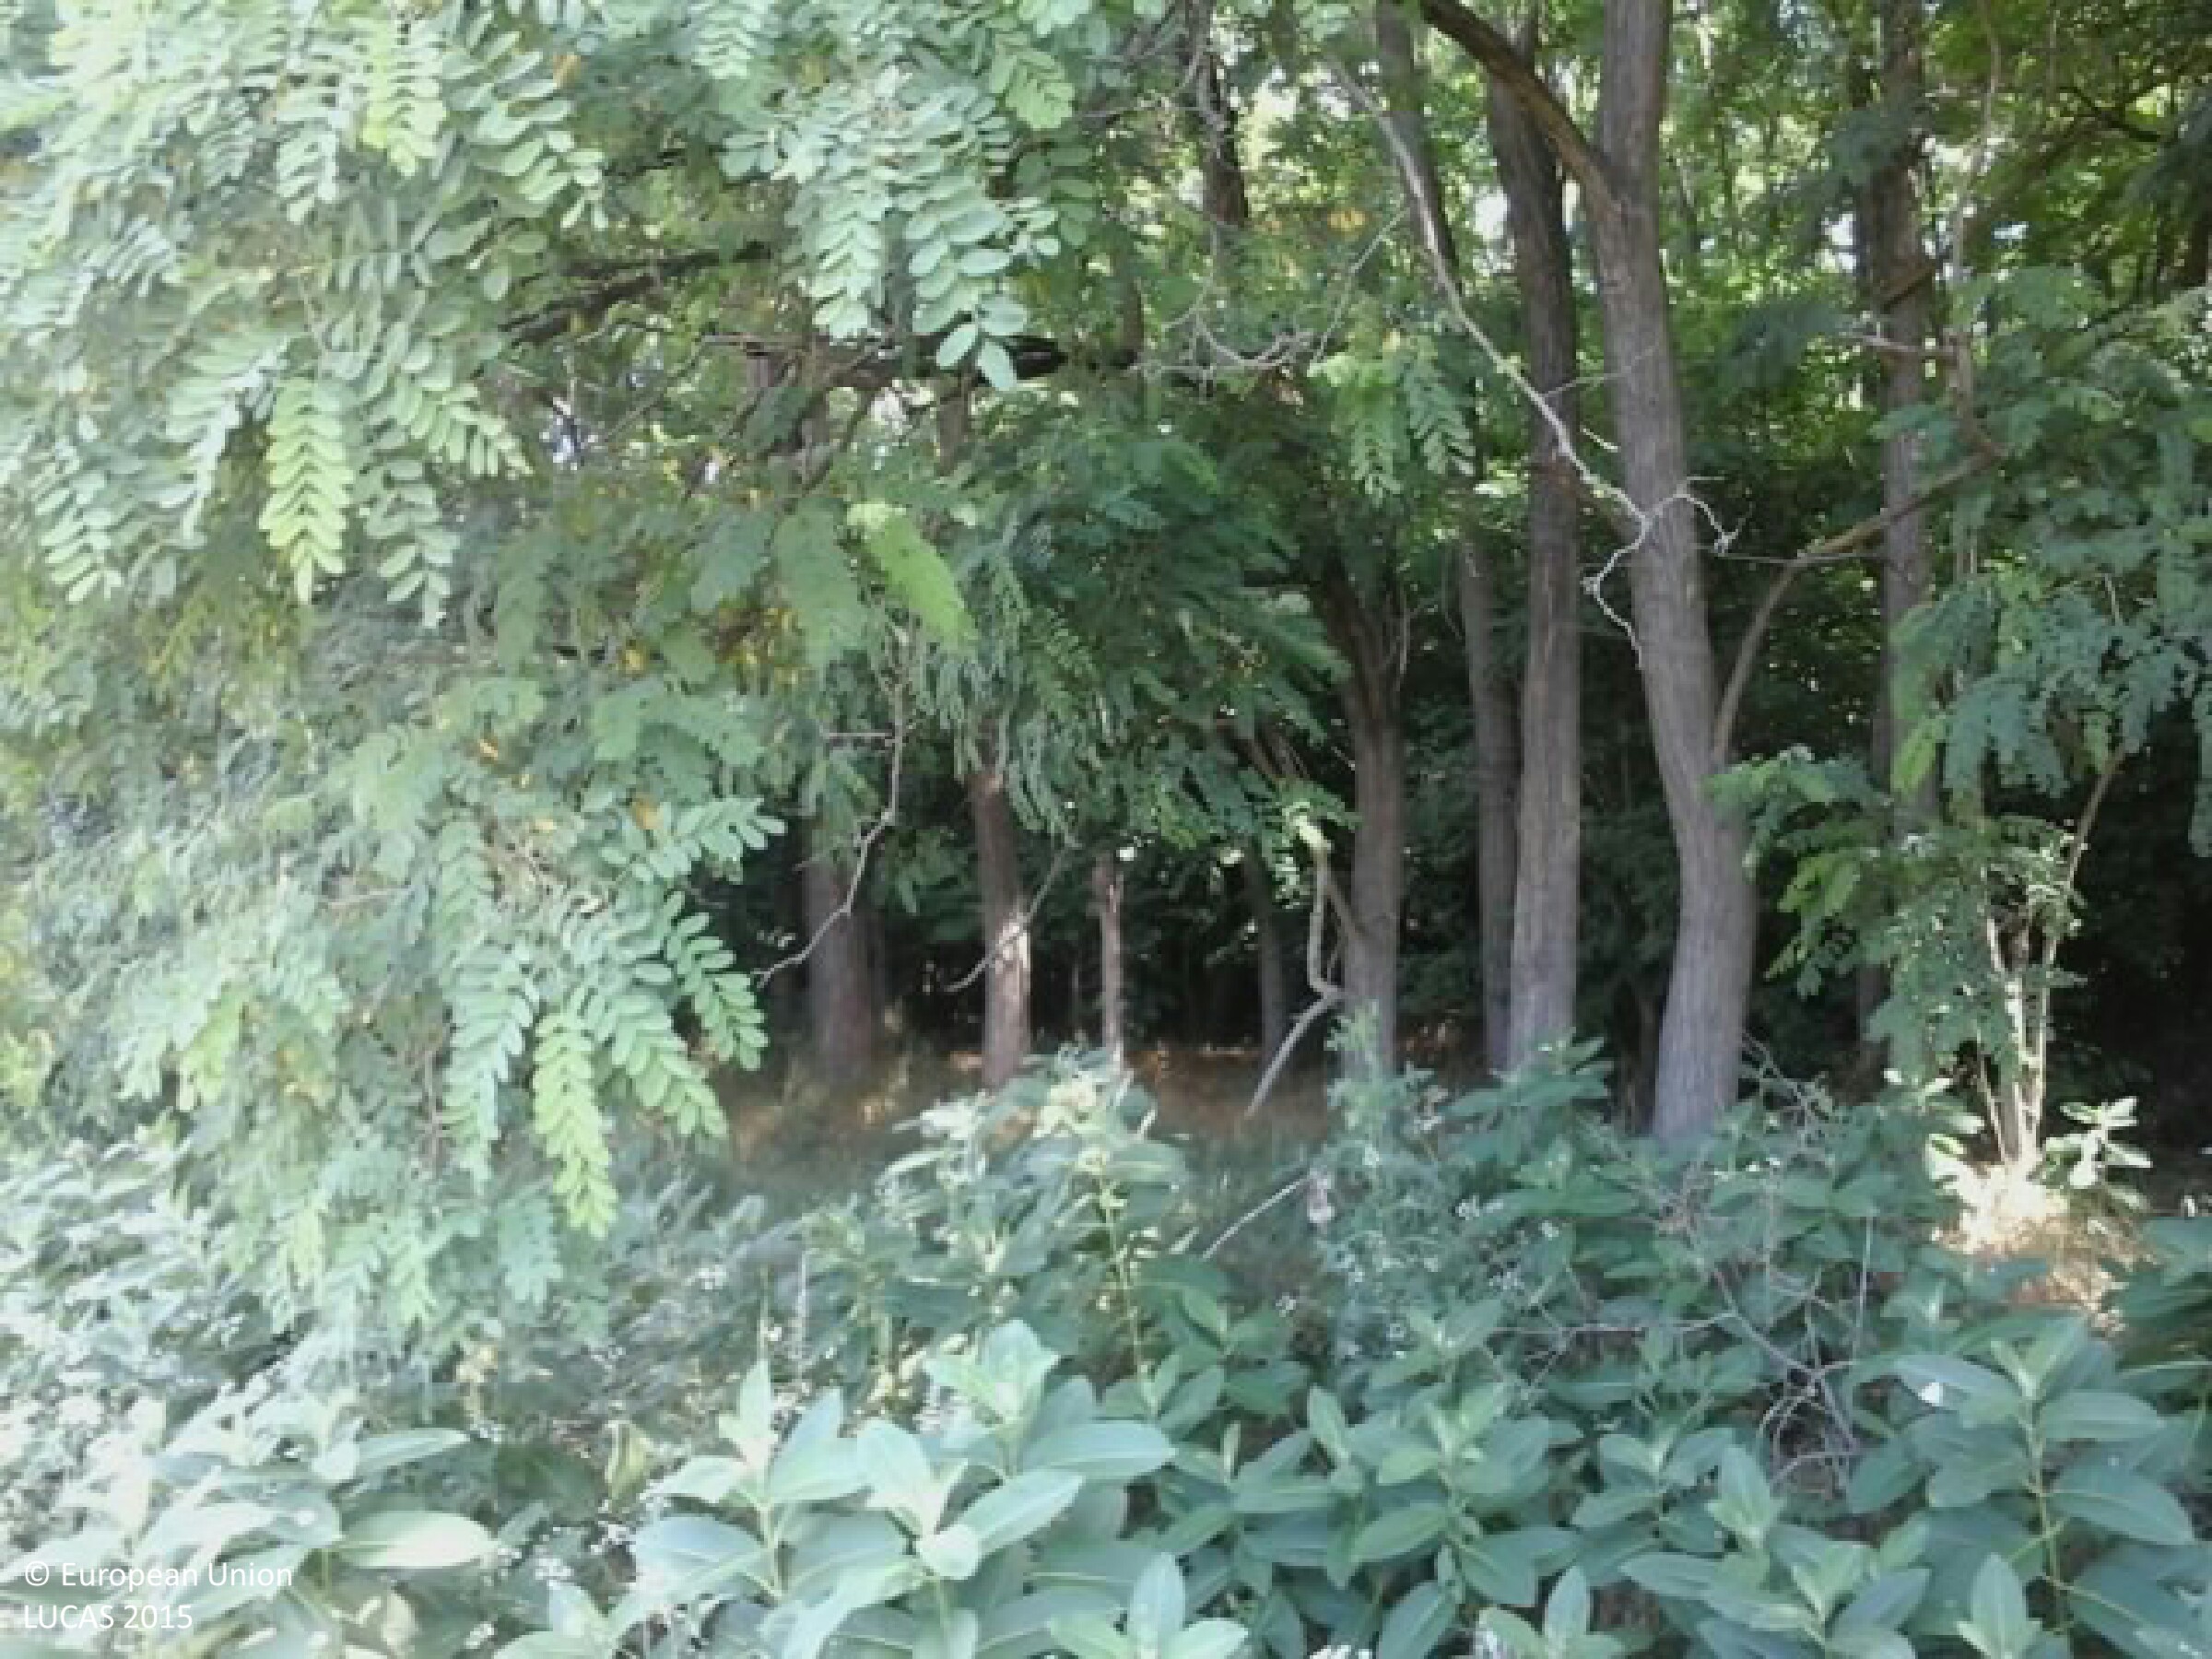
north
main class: Woodland
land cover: Broadleaved woodland
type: exotic forest
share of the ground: > 75 %
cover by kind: broadleaved forest trees 90 %, shrubs 10 %
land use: Forestry
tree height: > 5 m
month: June
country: HU
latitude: 47.6353
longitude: 19.2432
